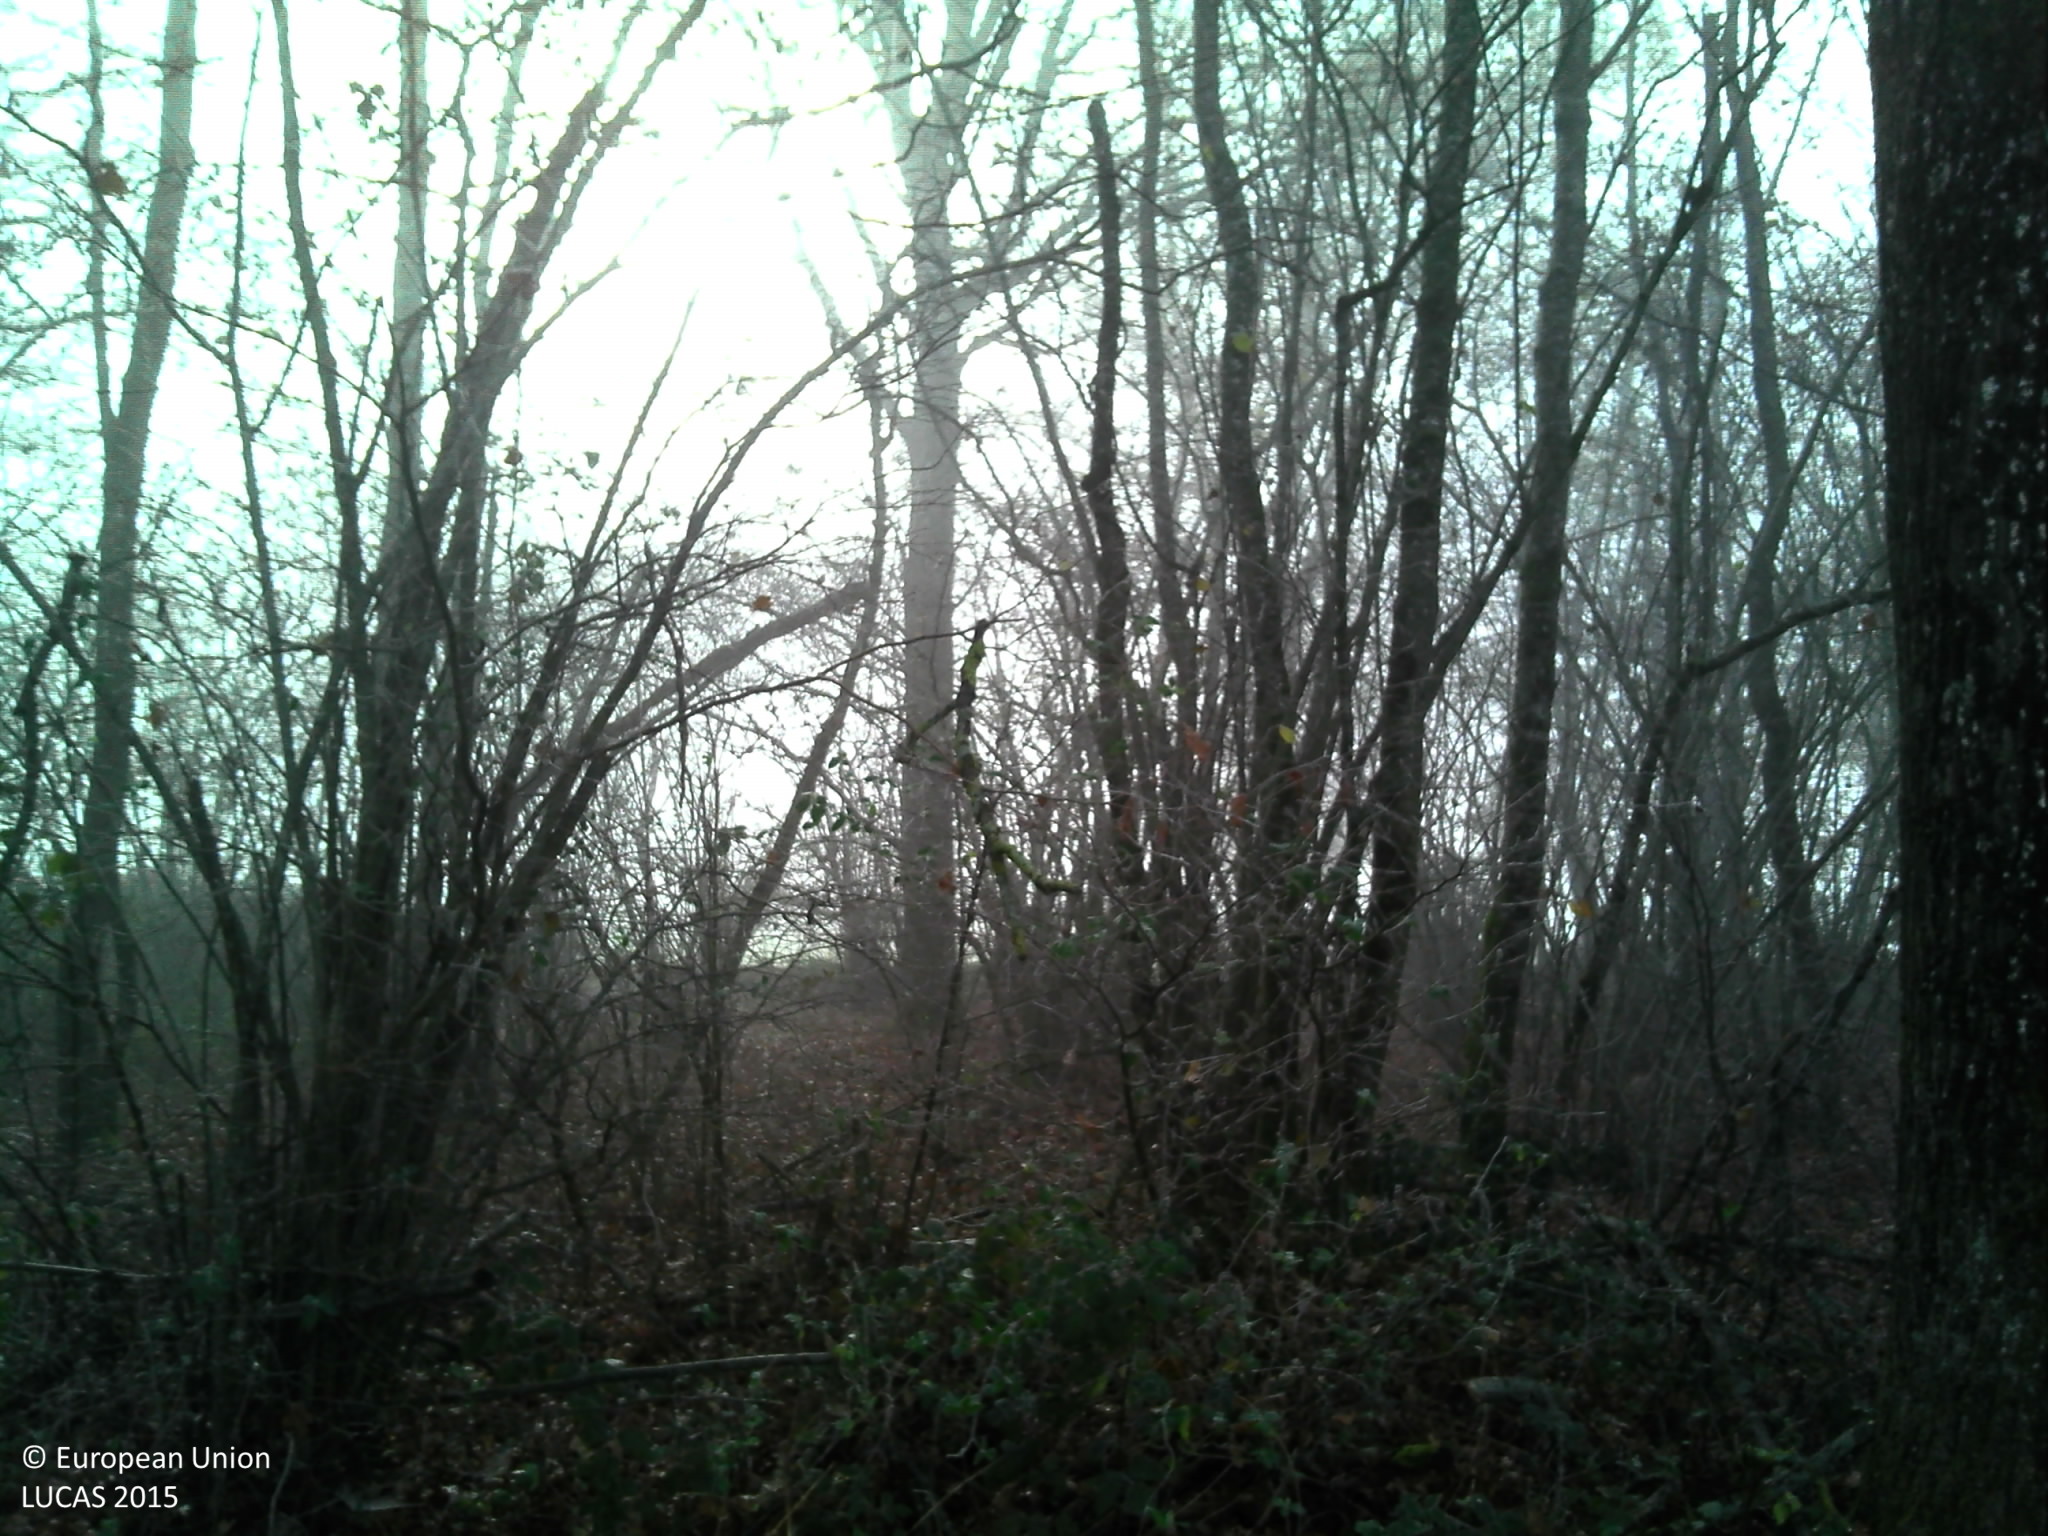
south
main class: Woodland
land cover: Broadleaved woodland
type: mesophytic deciduous forest
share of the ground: > 75 %
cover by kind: broadleaved forest trees 90 %, herbaceous plants 10 %
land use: Agriculture (excluding fallow land and kitchen gardens)
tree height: > 5 m
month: December
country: FR
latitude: 46.4036
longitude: 5.1508
